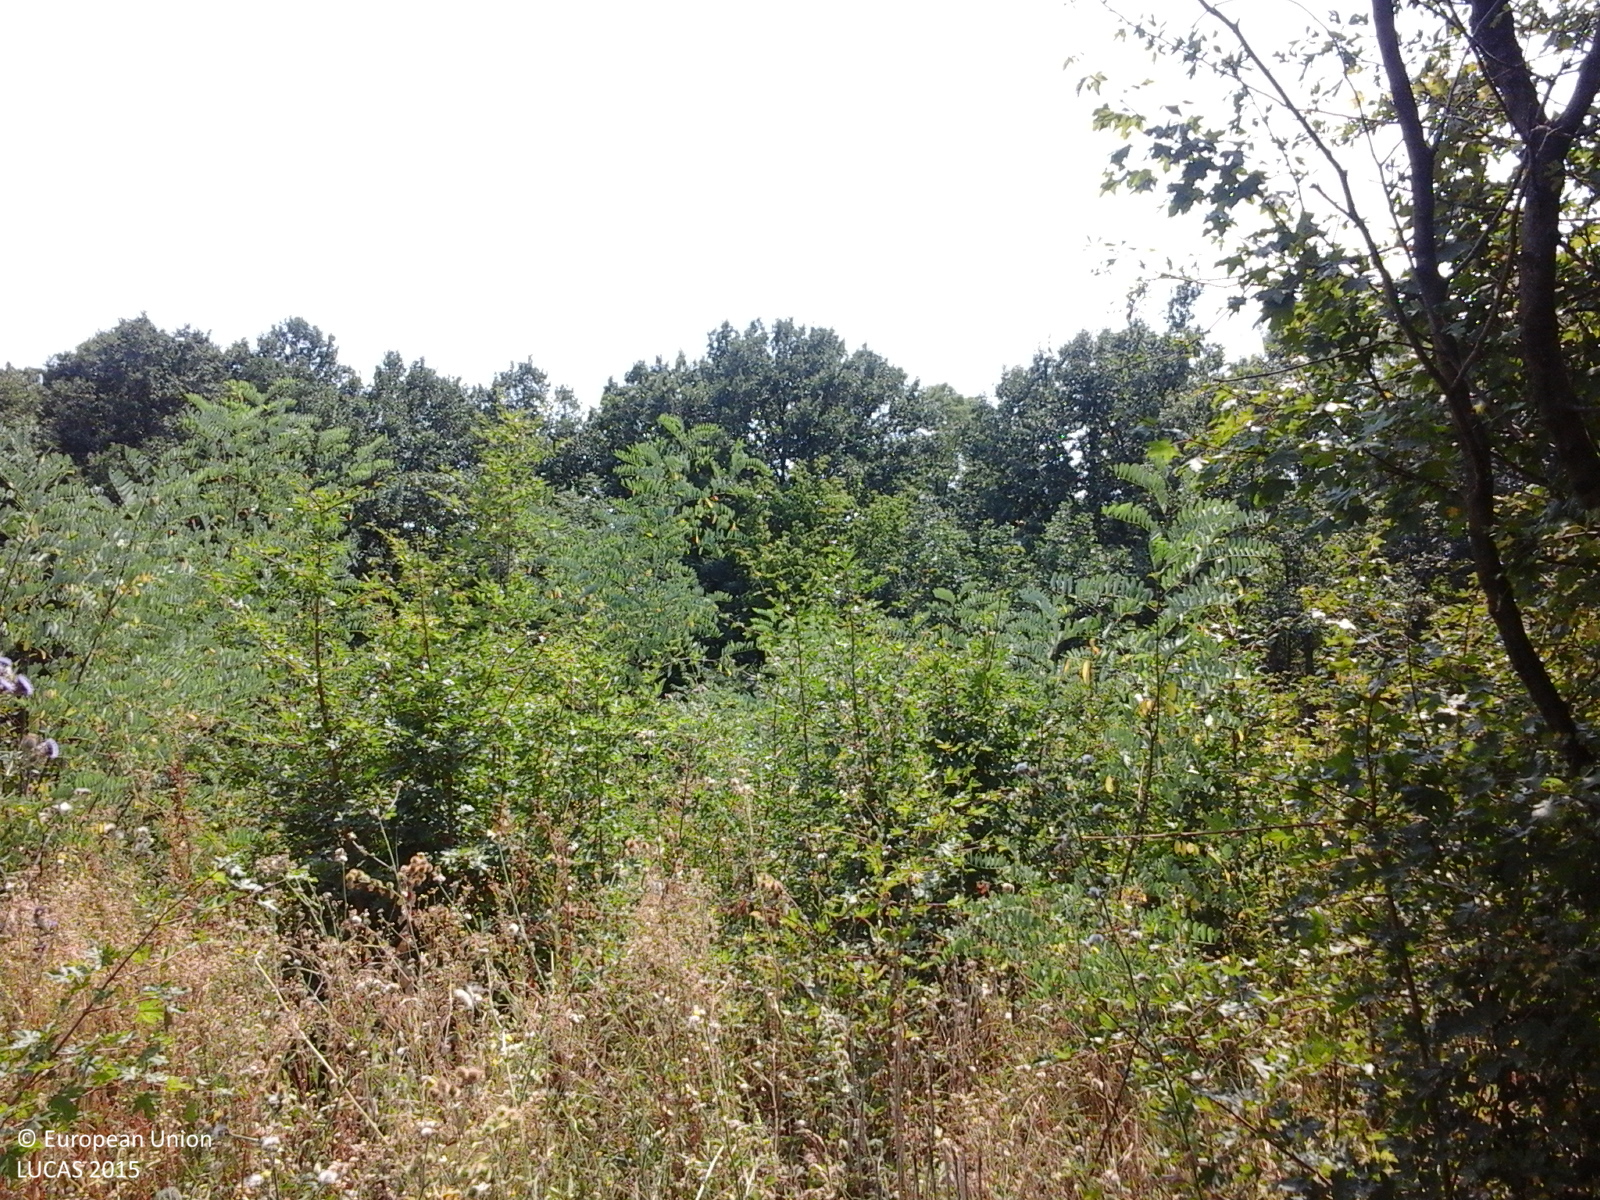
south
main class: Shrubland
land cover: Shrubland with sparse tree cover
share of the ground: > 75 %
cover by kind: shrubs 95 %, broadleaved forest trees 5 %
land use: Semi-natural and natural areas not in use
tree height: > 5 m
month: August
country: RO
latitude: 44.4116
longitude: 23.3746
